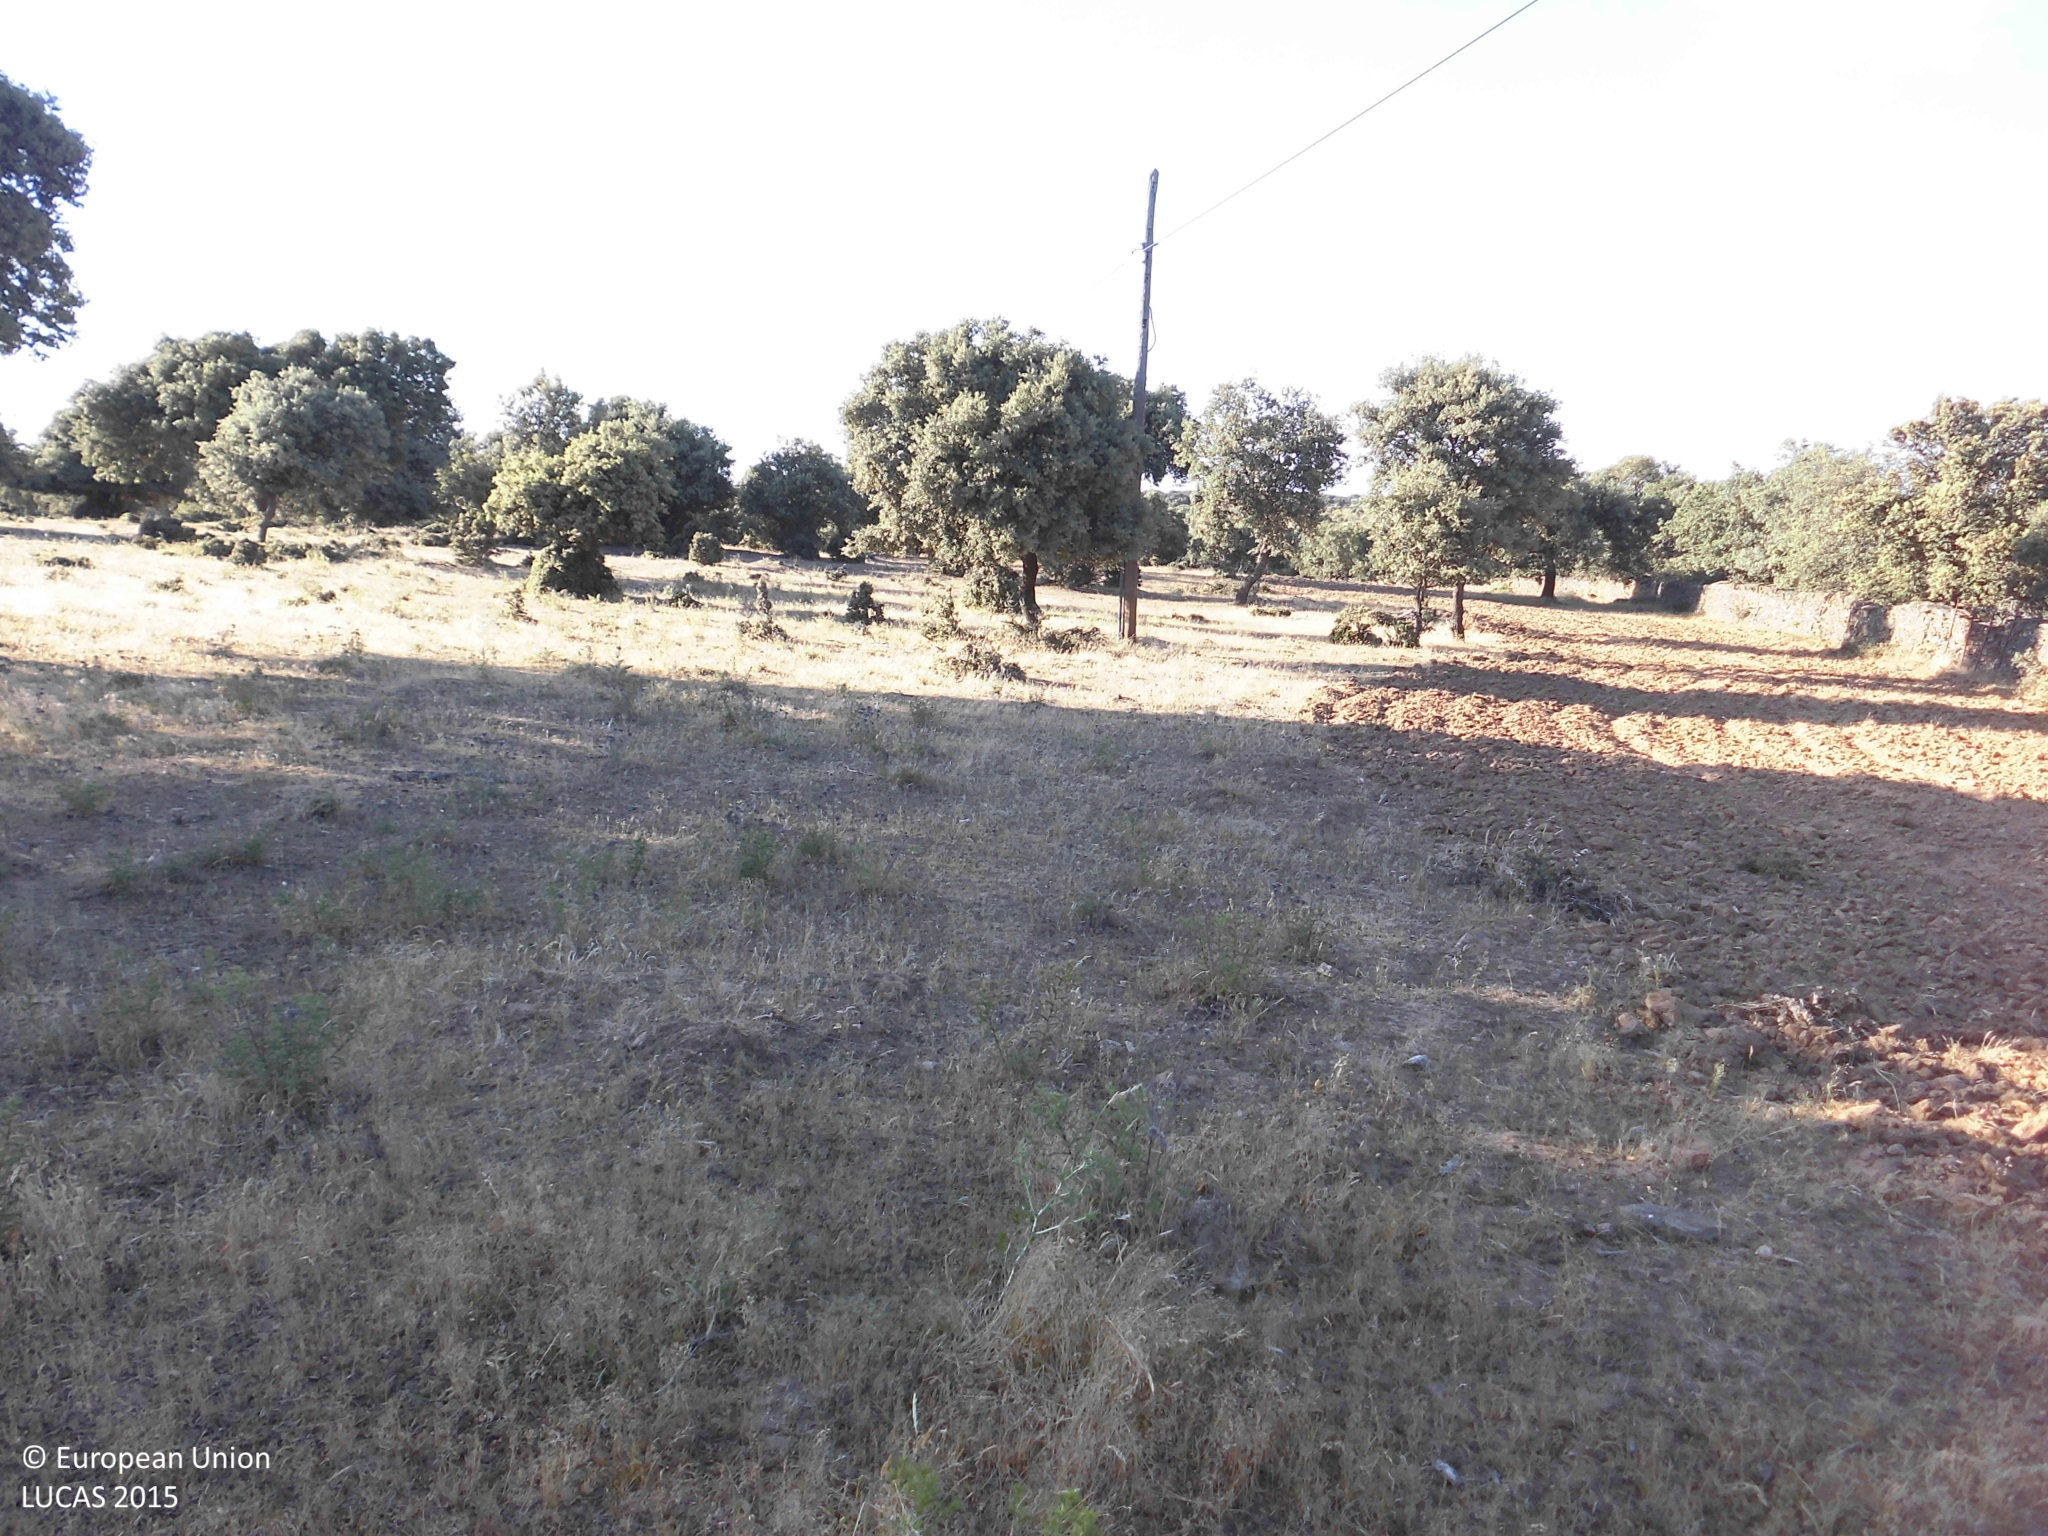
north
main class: Grassland
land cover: Grassland with sparse tree/shrub cover
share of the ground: > 75 %
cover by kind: herbaceous plants 85 %, broadleaved forest trees 5 %, shrubs 5 %, unconsolidated bare surface 5 %
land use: Agriculture (excluding fallow land and kitchen gardens)
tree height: < 5 m
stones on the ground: < 10 %
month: May
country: ES
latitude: 39.4255
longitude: -5.9859
